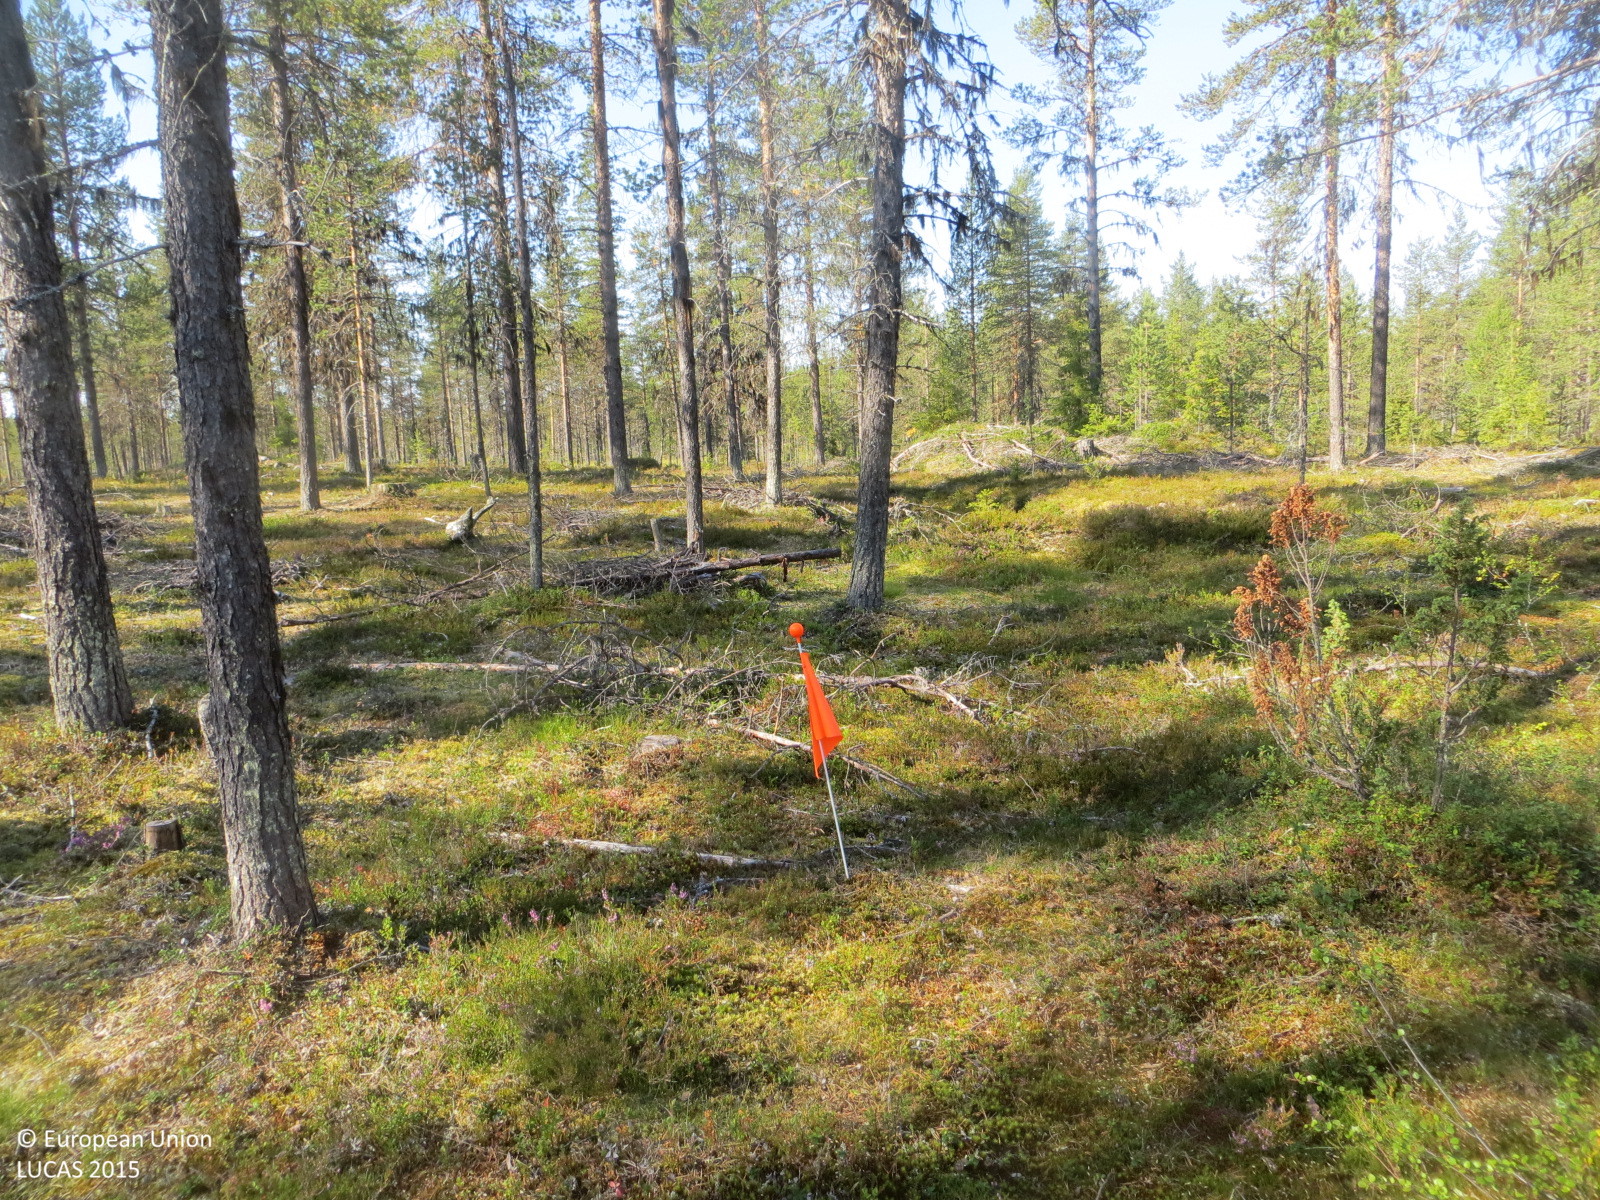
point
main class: Woodland
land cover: Pine dominated coniferous woodland
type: boreal forest
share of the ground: 50 - 75 %
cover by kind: coniferous forest trees 50 %, shrubs 50 %
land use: Forestry
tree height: > 5 m
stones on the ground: < 10 %
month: August
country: FI
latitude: 67.7104
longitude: 24.1264
